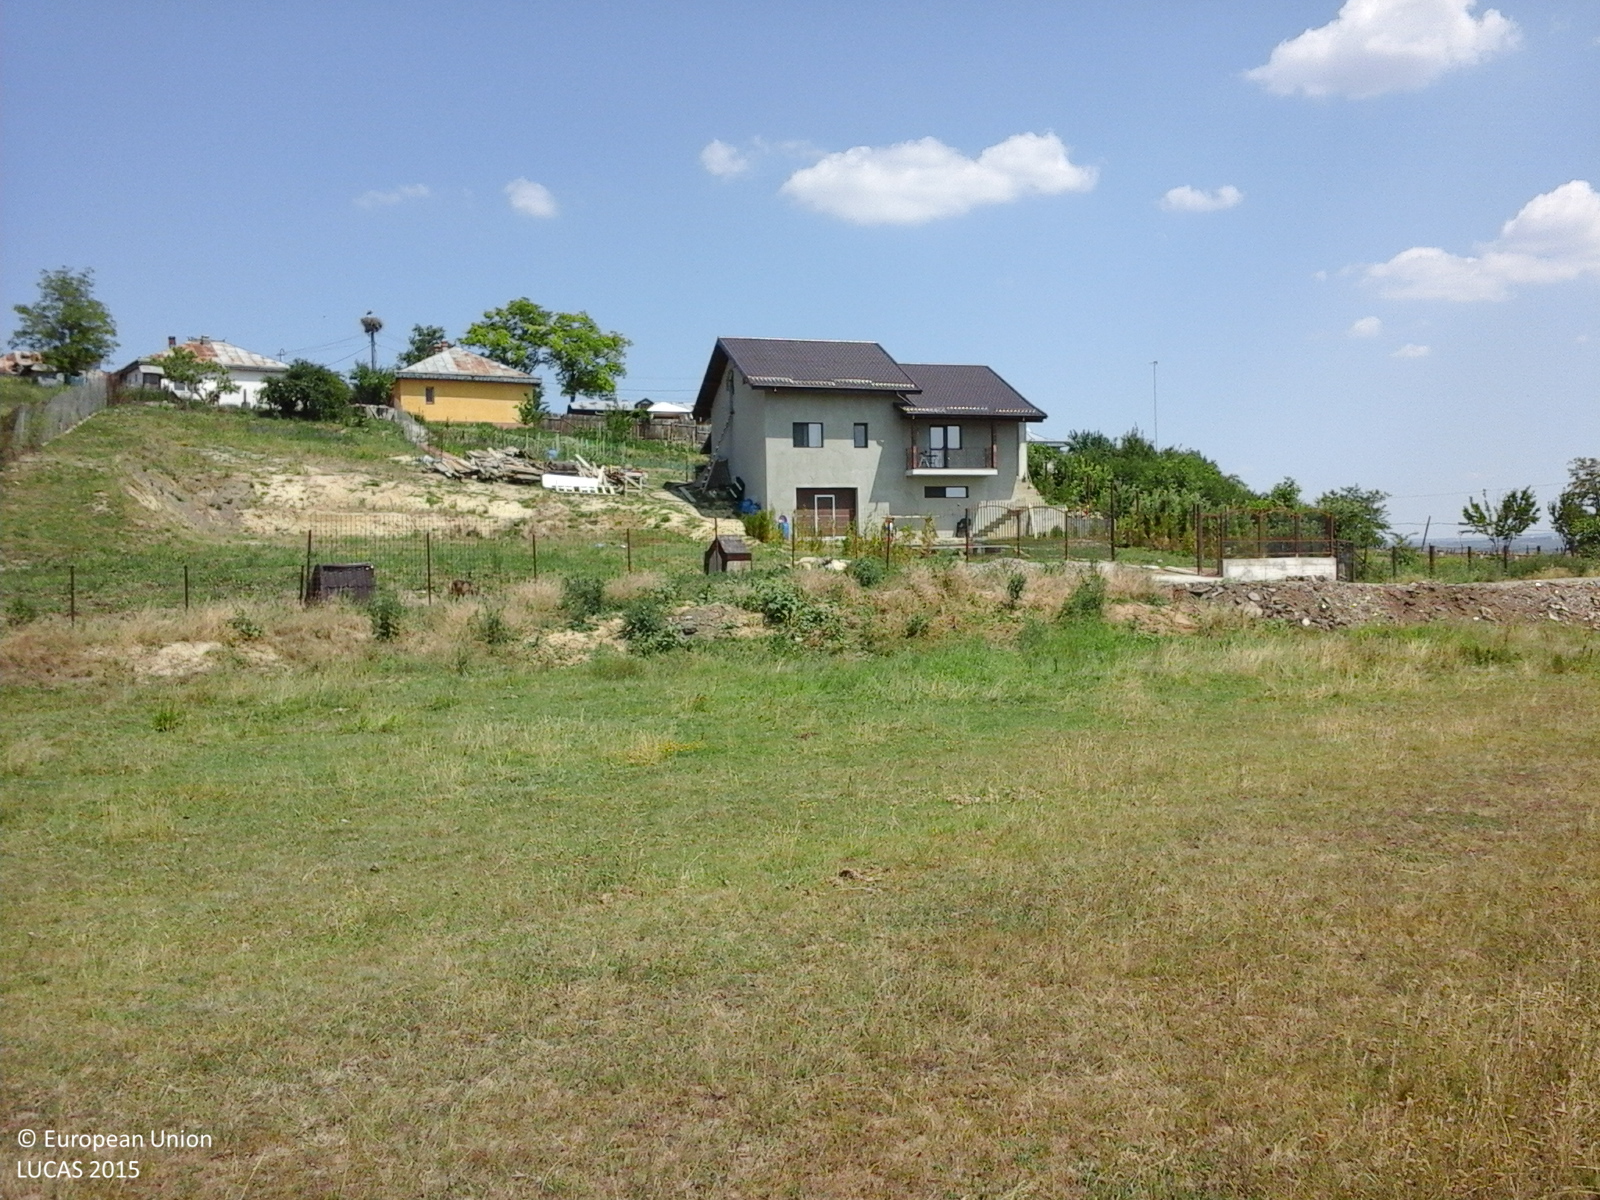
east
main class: Grassland
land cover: Grassland without tree/shrub cover
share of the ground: > 75 %
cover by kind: herbaceous plants 100 %
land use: Agriculture (excluding fallow land and kitchen gardens)
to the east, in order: Grassland without tree/shrub cover; Artificial constructions in urban areas; Grassland with sparse tree/shrub cover
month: June
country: RO
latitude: 47.1908
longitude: 27.4162
